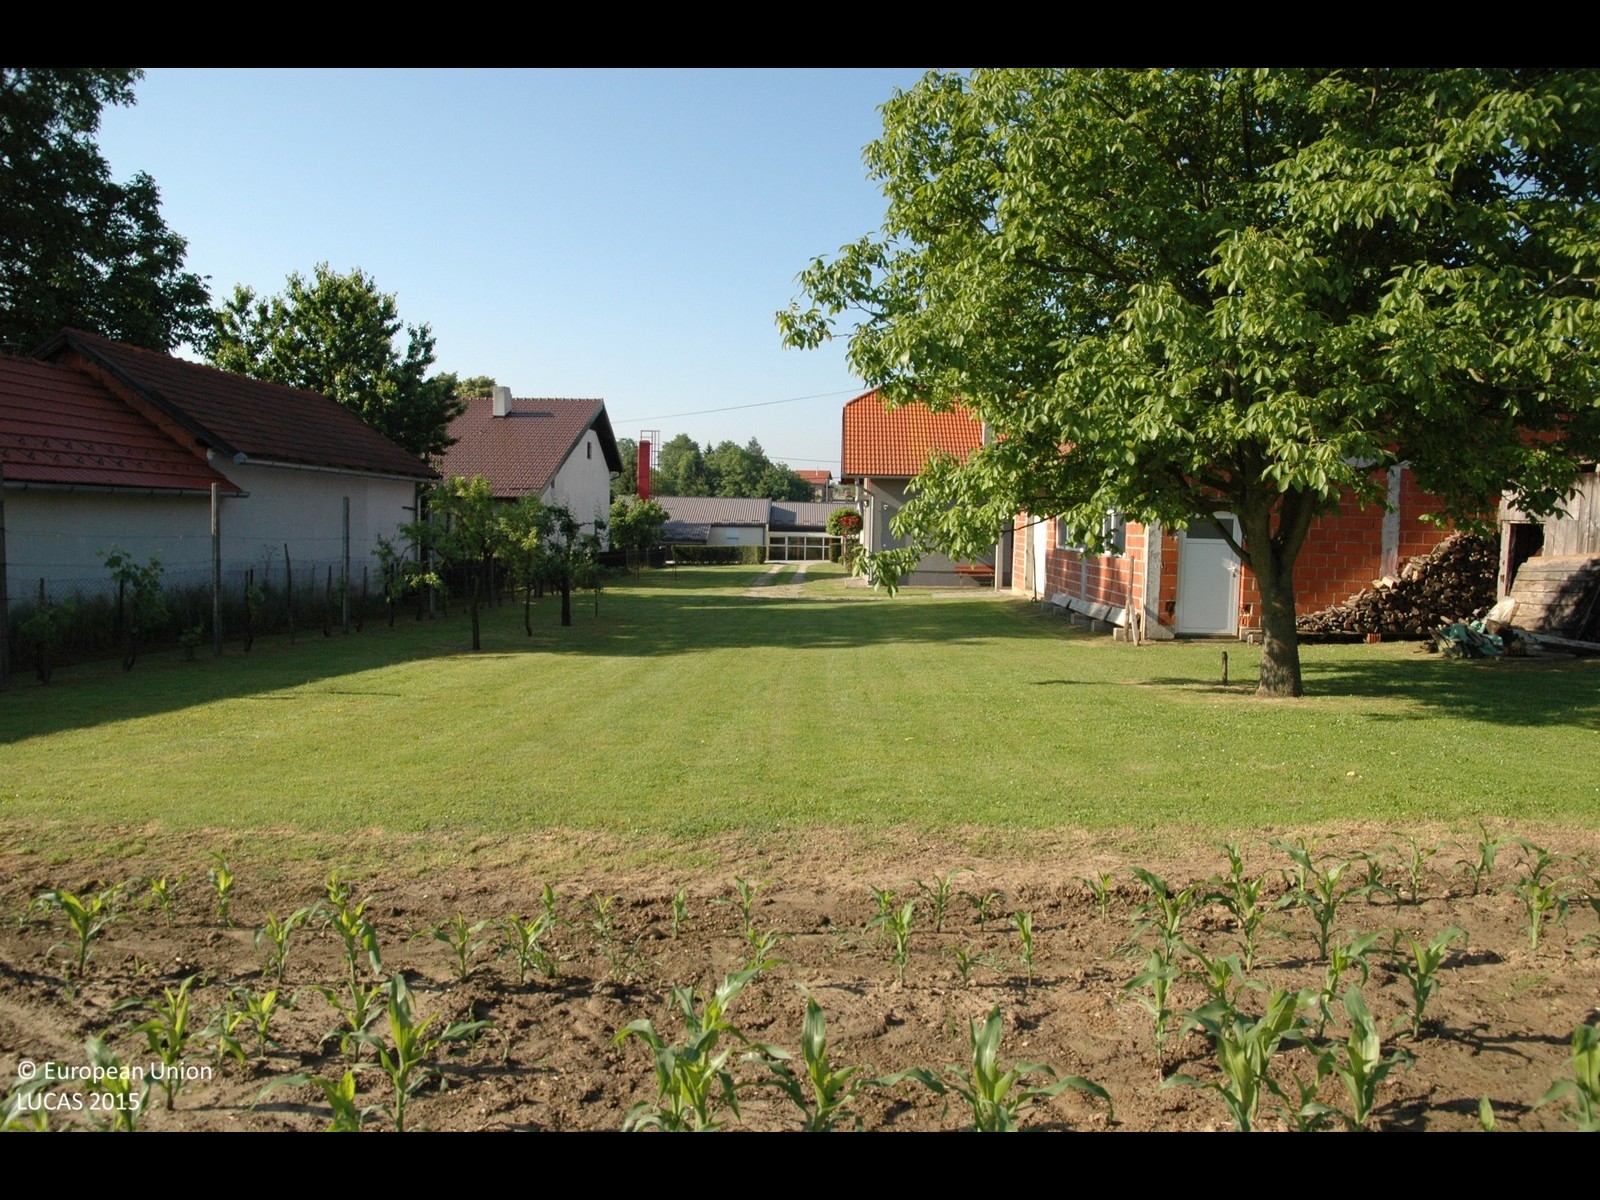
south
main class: Cropland
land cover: Maize
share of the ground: 25 - 50 %
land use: Agriculture (excluding fallow land and kitchen gardens)
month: May
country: HR
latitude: 46.4981
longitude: 16.4769
